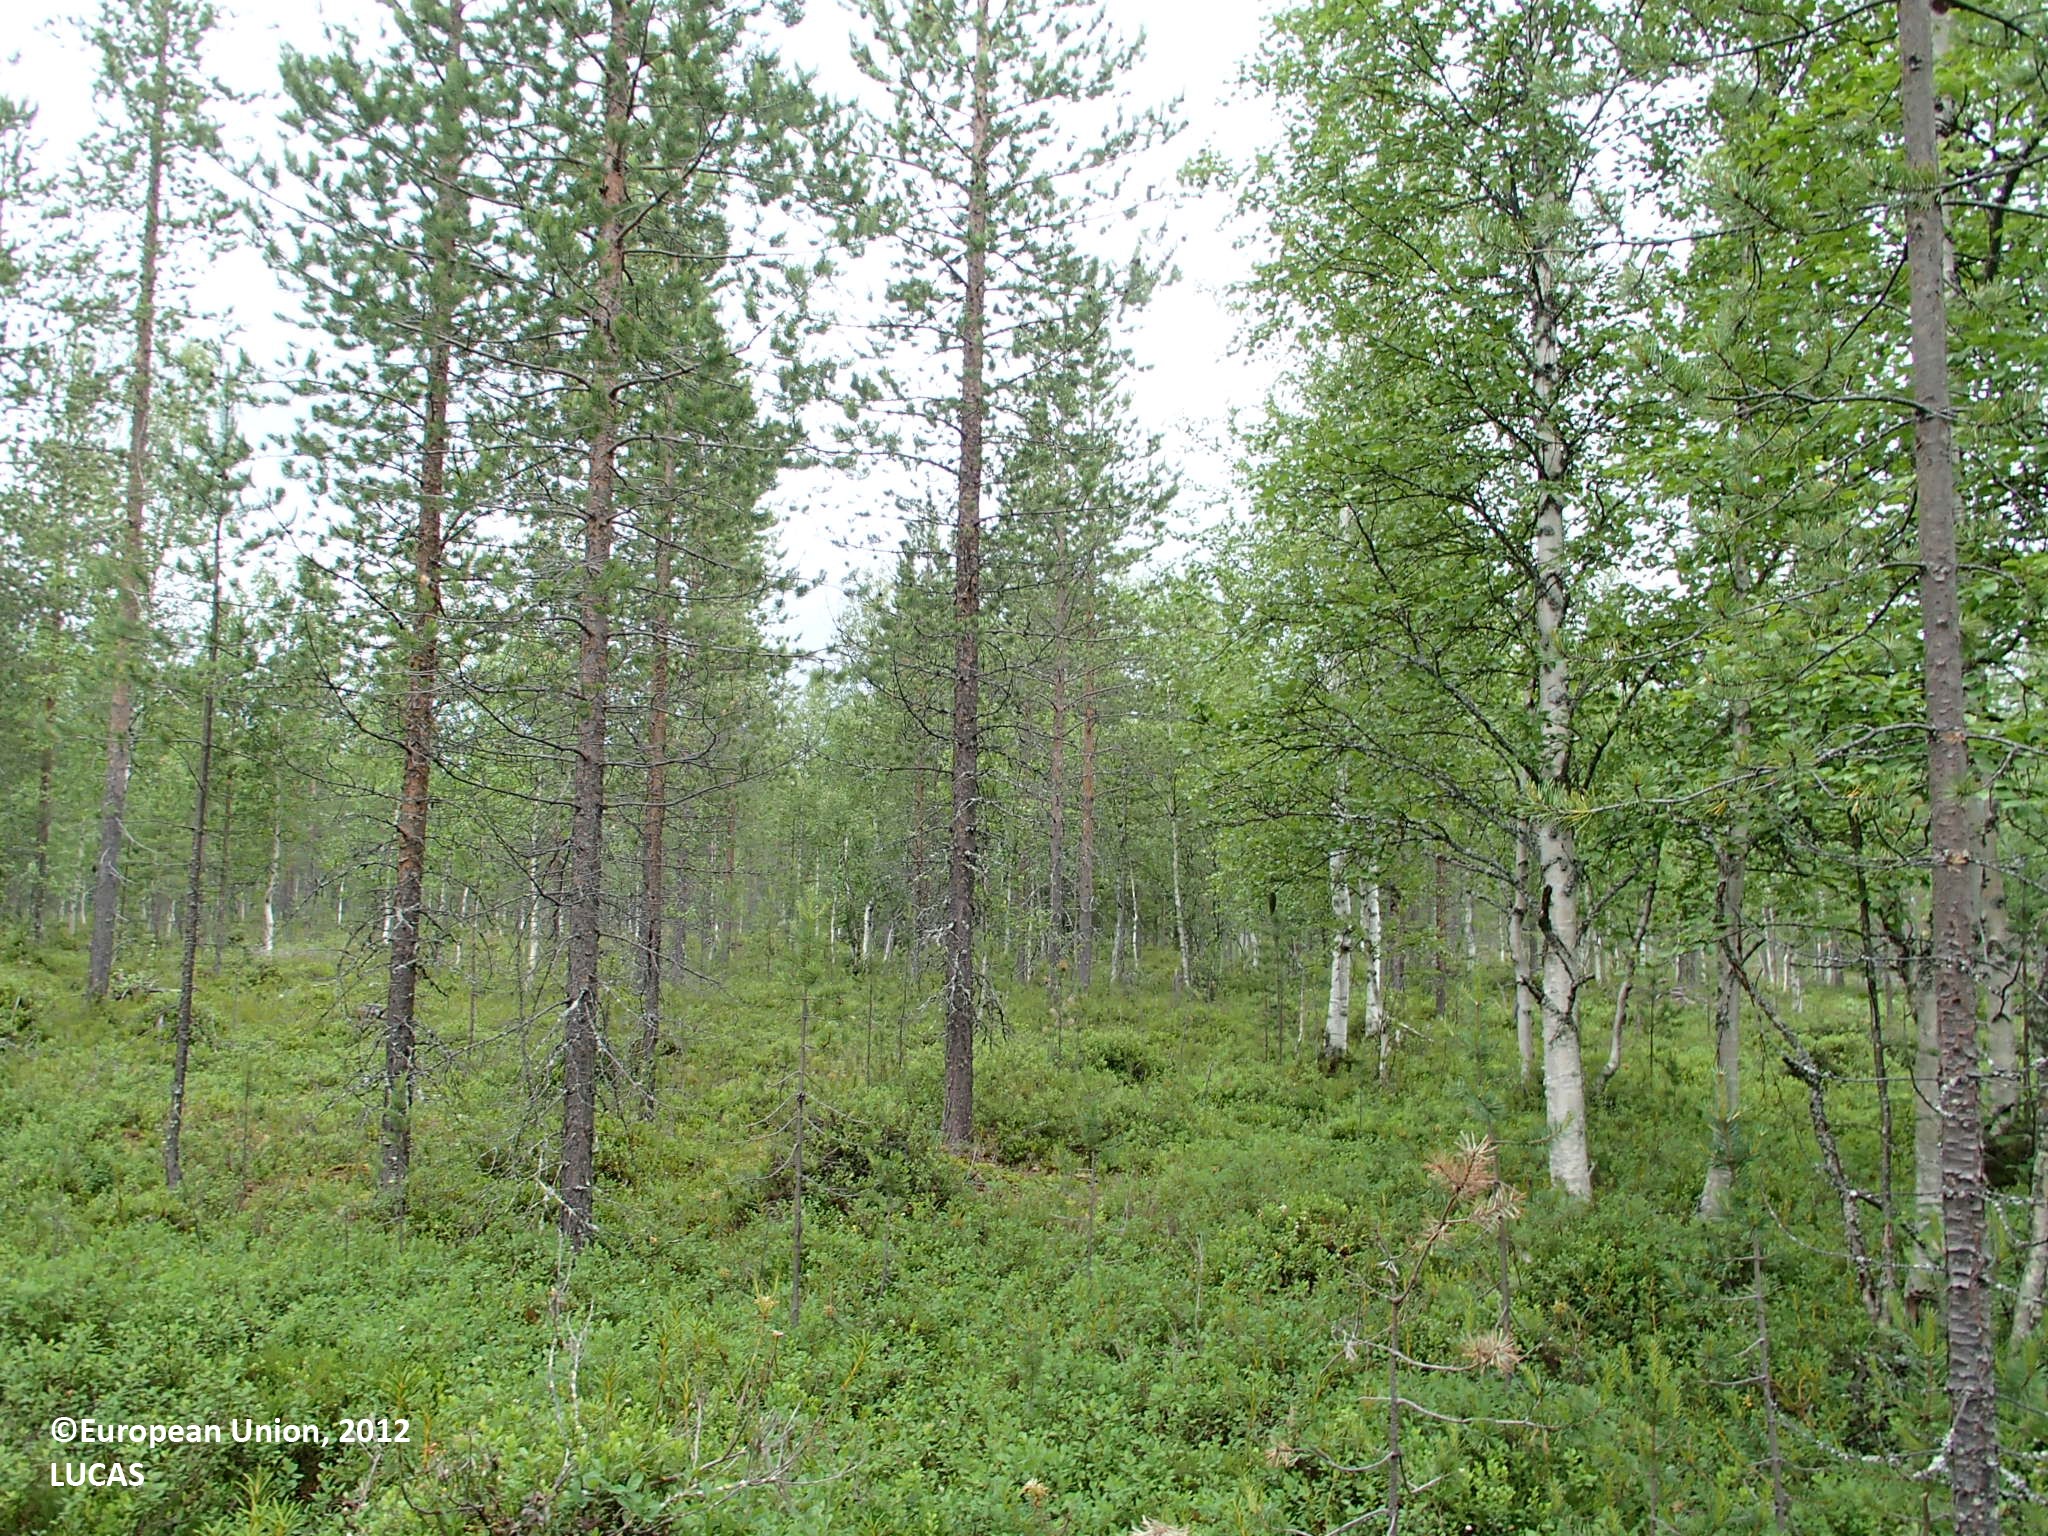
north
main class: Woodland
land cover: Other mixed woodland
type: boreal forest
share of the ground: 50 - 75 %
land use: Forestry
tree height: > 5 m
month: July
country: FI
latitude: 67.2209
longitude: 25.7271
